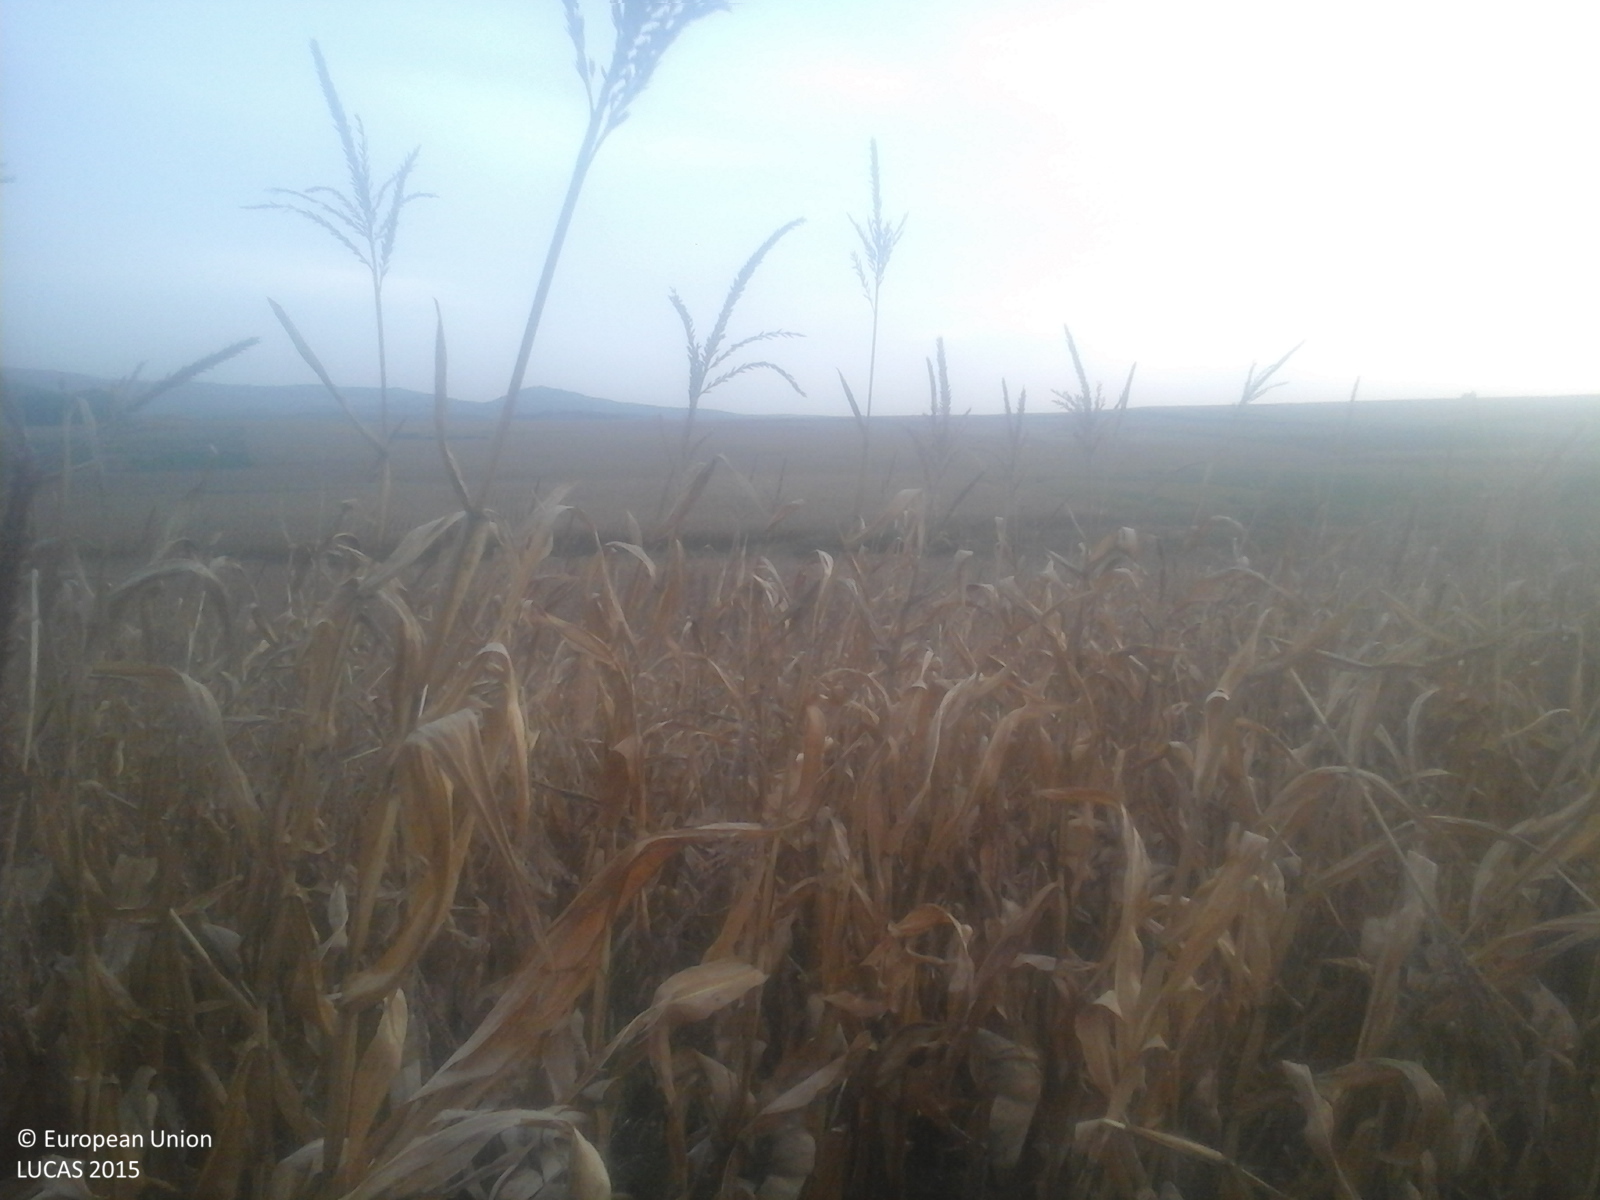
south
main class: Cropland
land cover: Maize
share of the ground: > 75 %
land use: Agriculture (excluding fallow land and kitchen gardens)
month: September
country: RO
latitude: 46.9084
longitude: 24.3844
